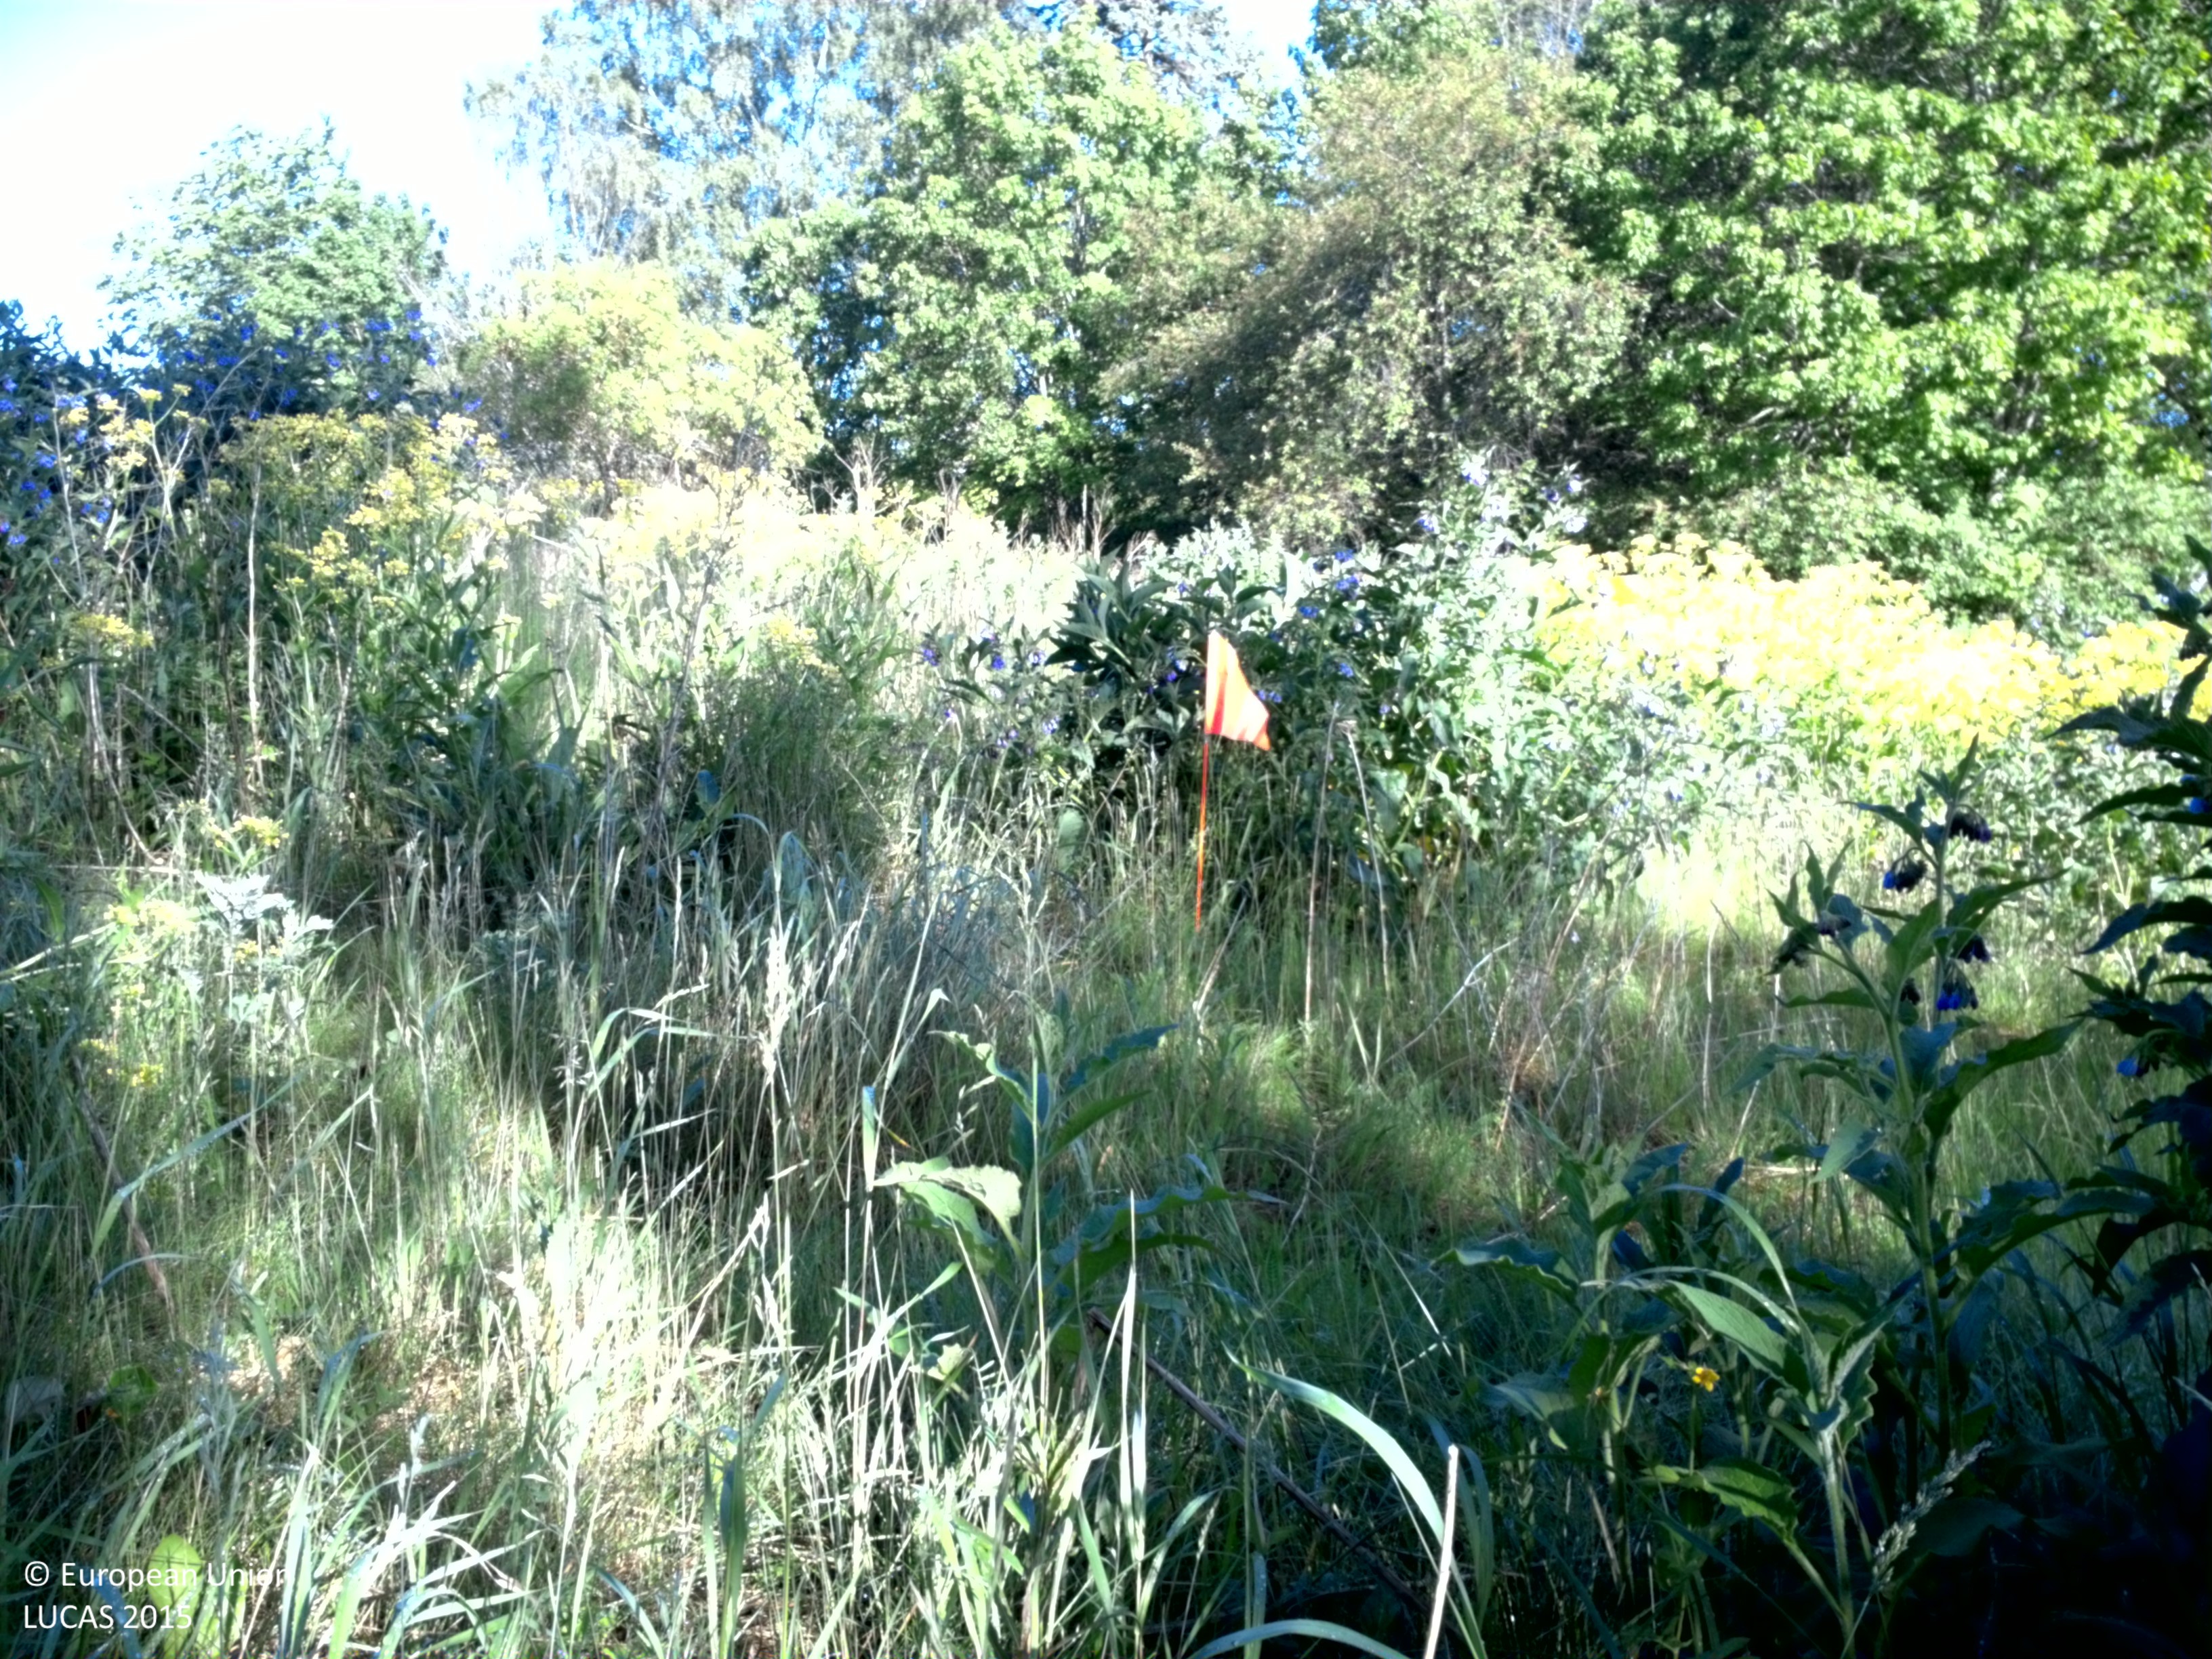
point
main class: Grassland
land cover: Grassland without tree/shrub cover
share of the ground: > 75 %
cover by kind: herbaceous plants 95 %, shrubs 5 %
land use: Semi-natural and natural areas not in use
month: June
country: SE
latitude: 59.8839
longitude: 17.6237
